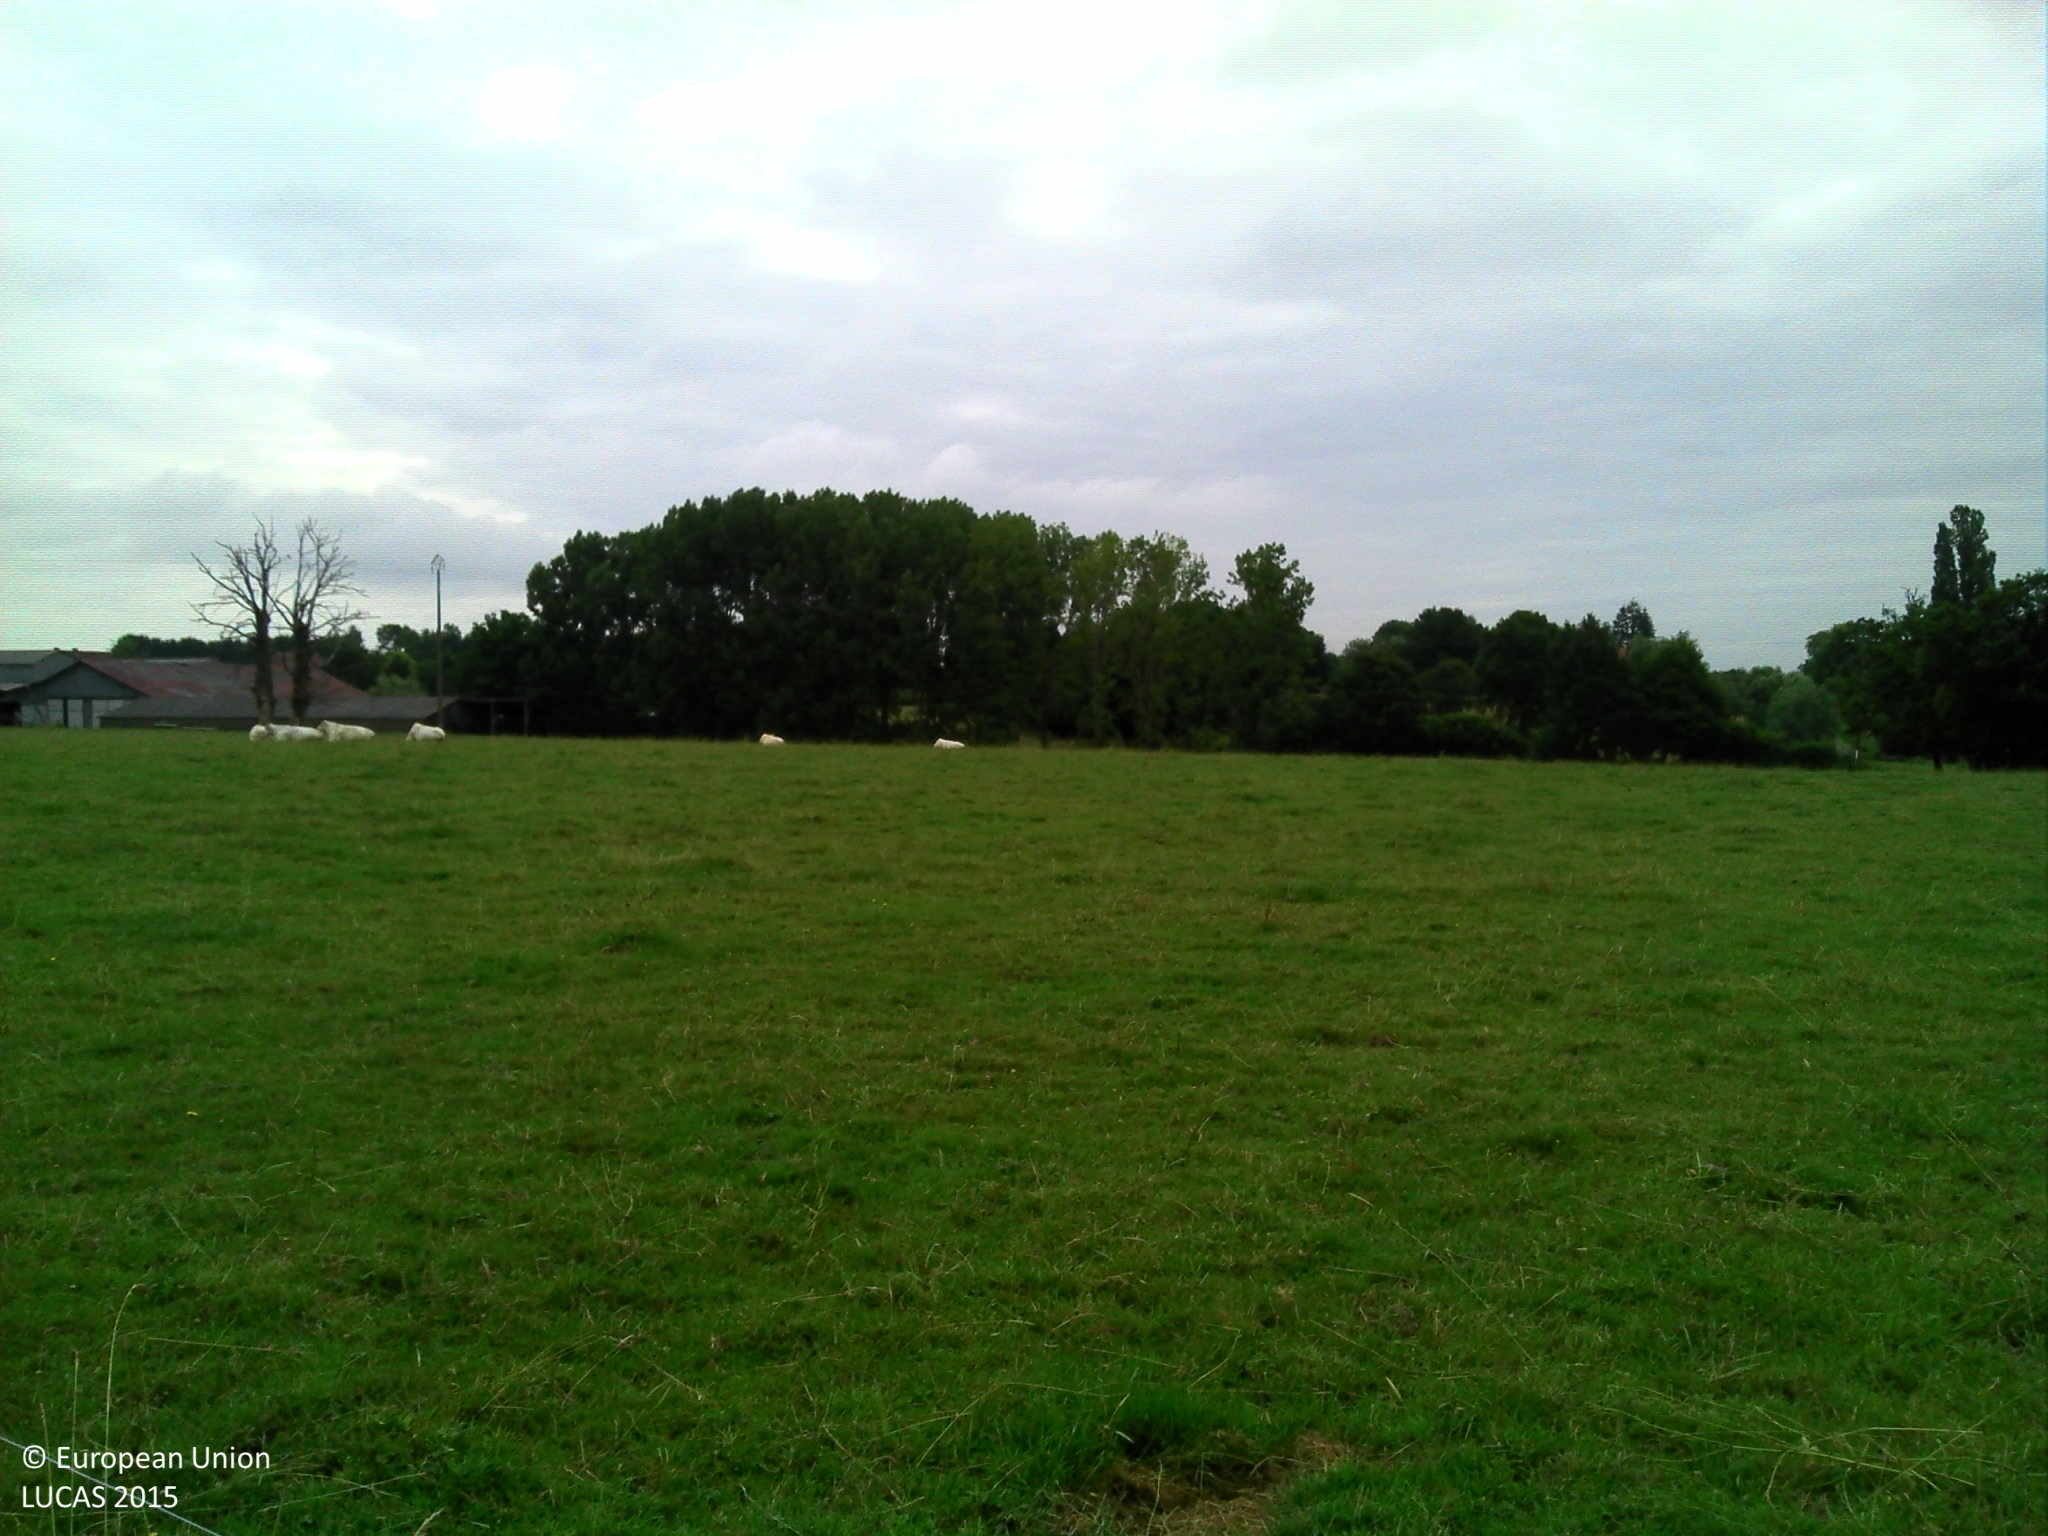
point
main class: Grassland
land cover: Grassland without tree/shrub cover
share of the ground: > 75 %
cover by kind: herbaceous plants 100 %
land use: Agriculture (excluding fallow land and kitchen gardens)
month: June
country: FR
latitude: 46.2880
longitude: 3.0537
